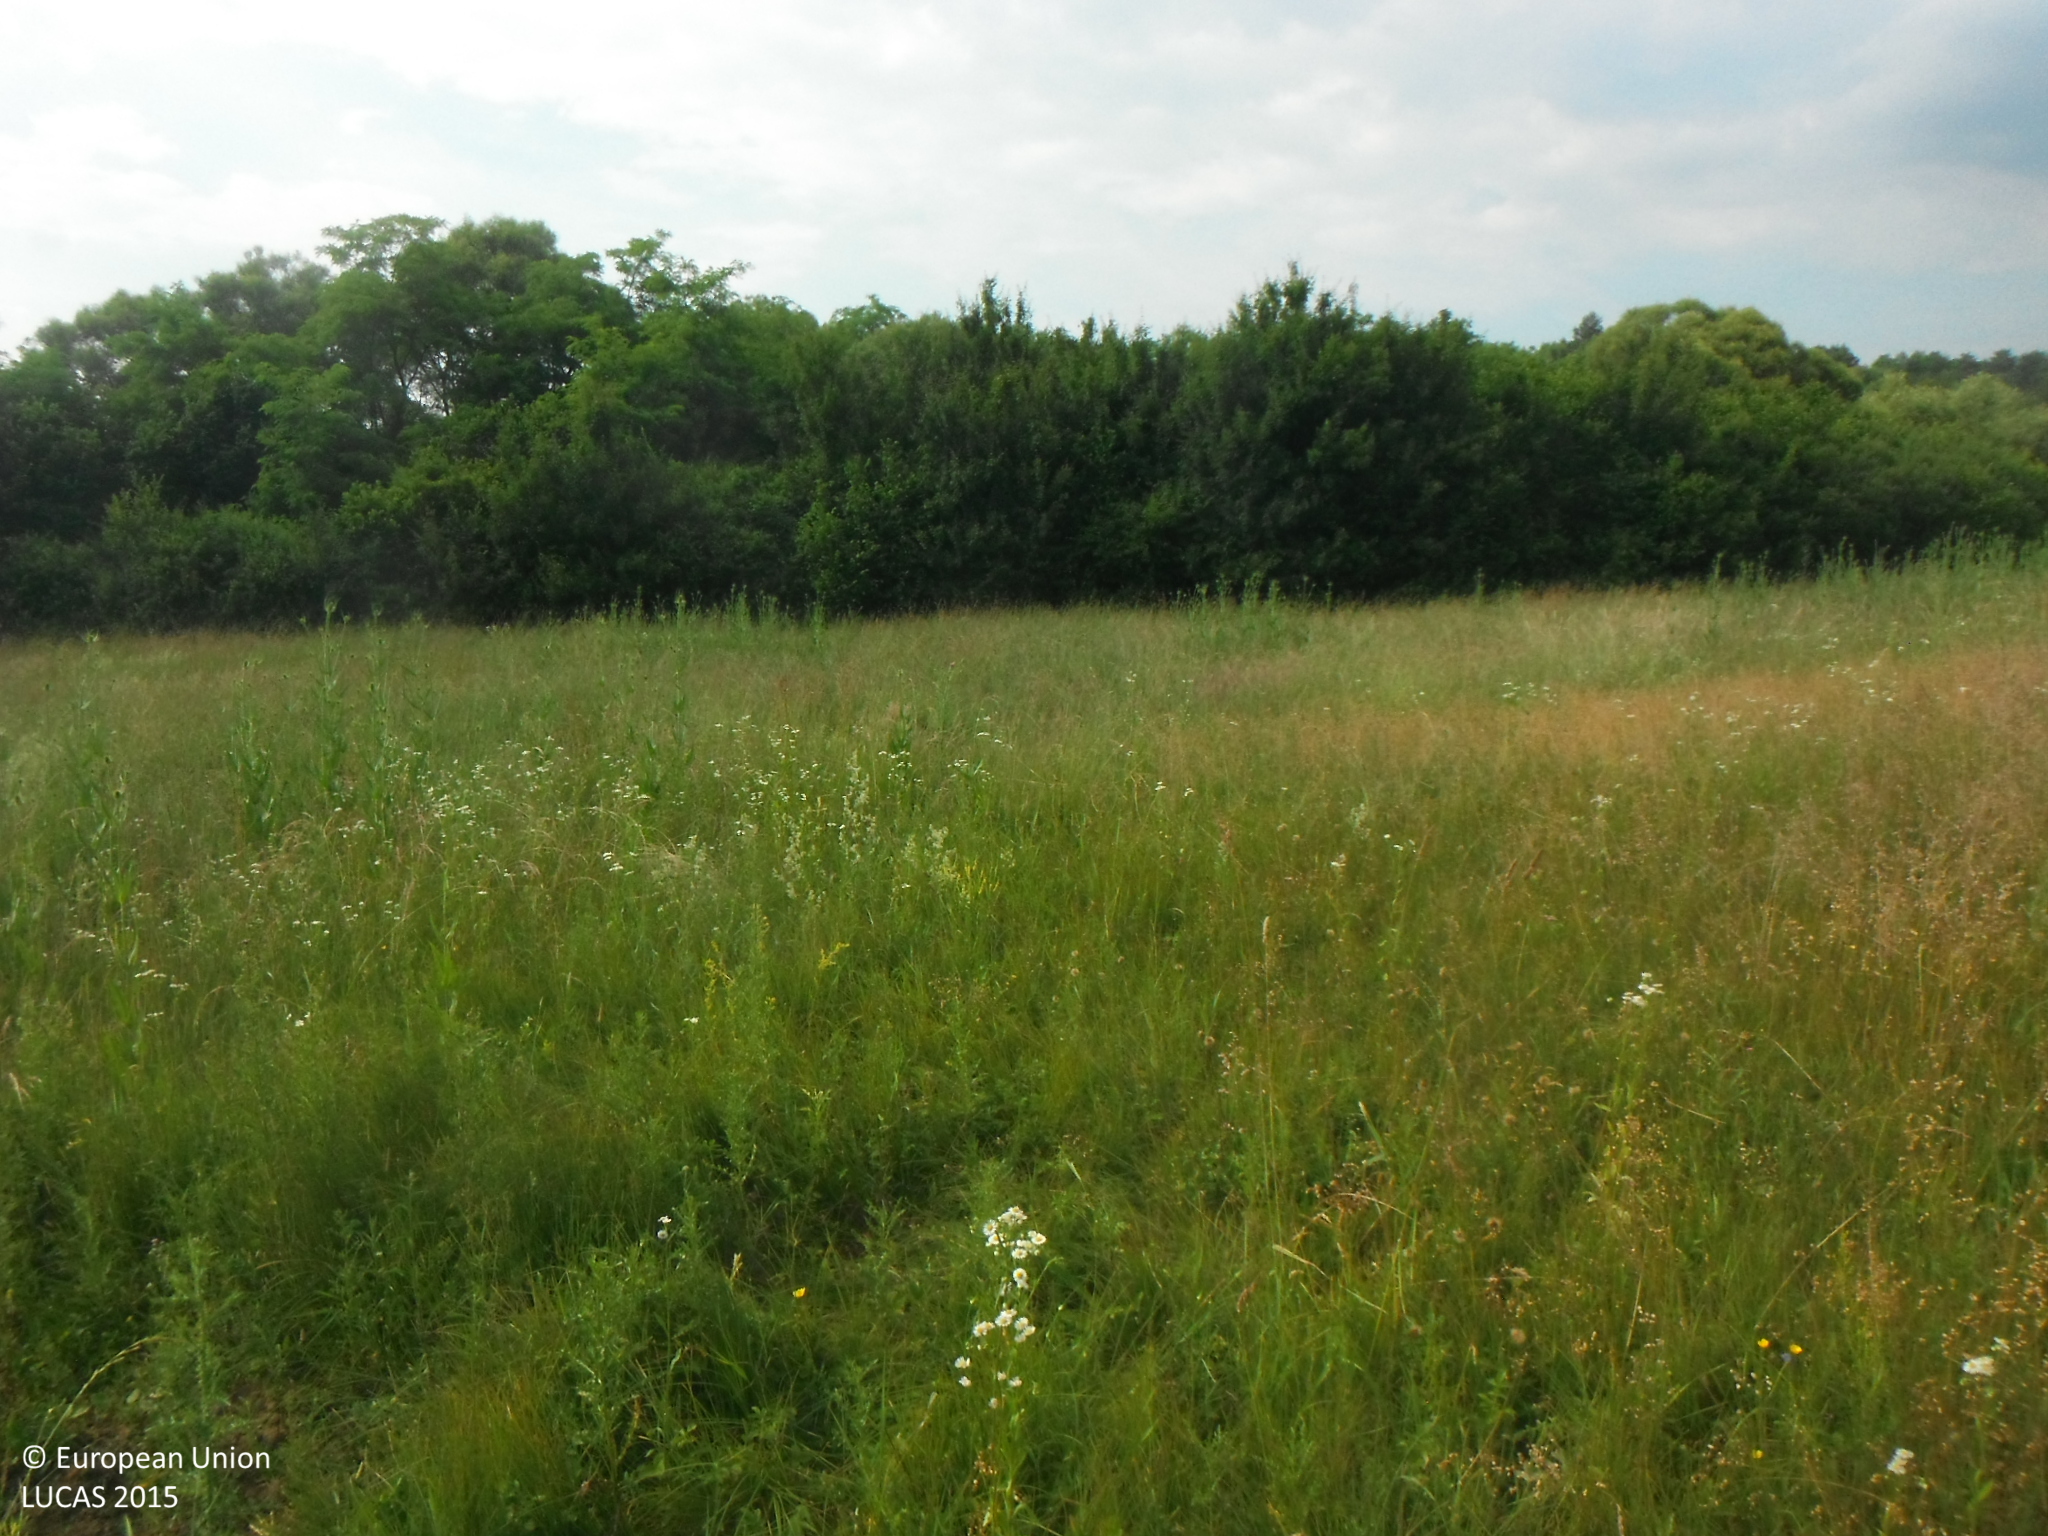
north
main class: Grassland
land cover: Grassland without tree/shrub cover
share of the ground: > 75 %
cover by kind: herbaceous plants 100 %
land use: Agriculture (excluding fallow land and kitchen gardens)
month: July
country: SK
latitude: 49.0414
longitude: 21.8041
